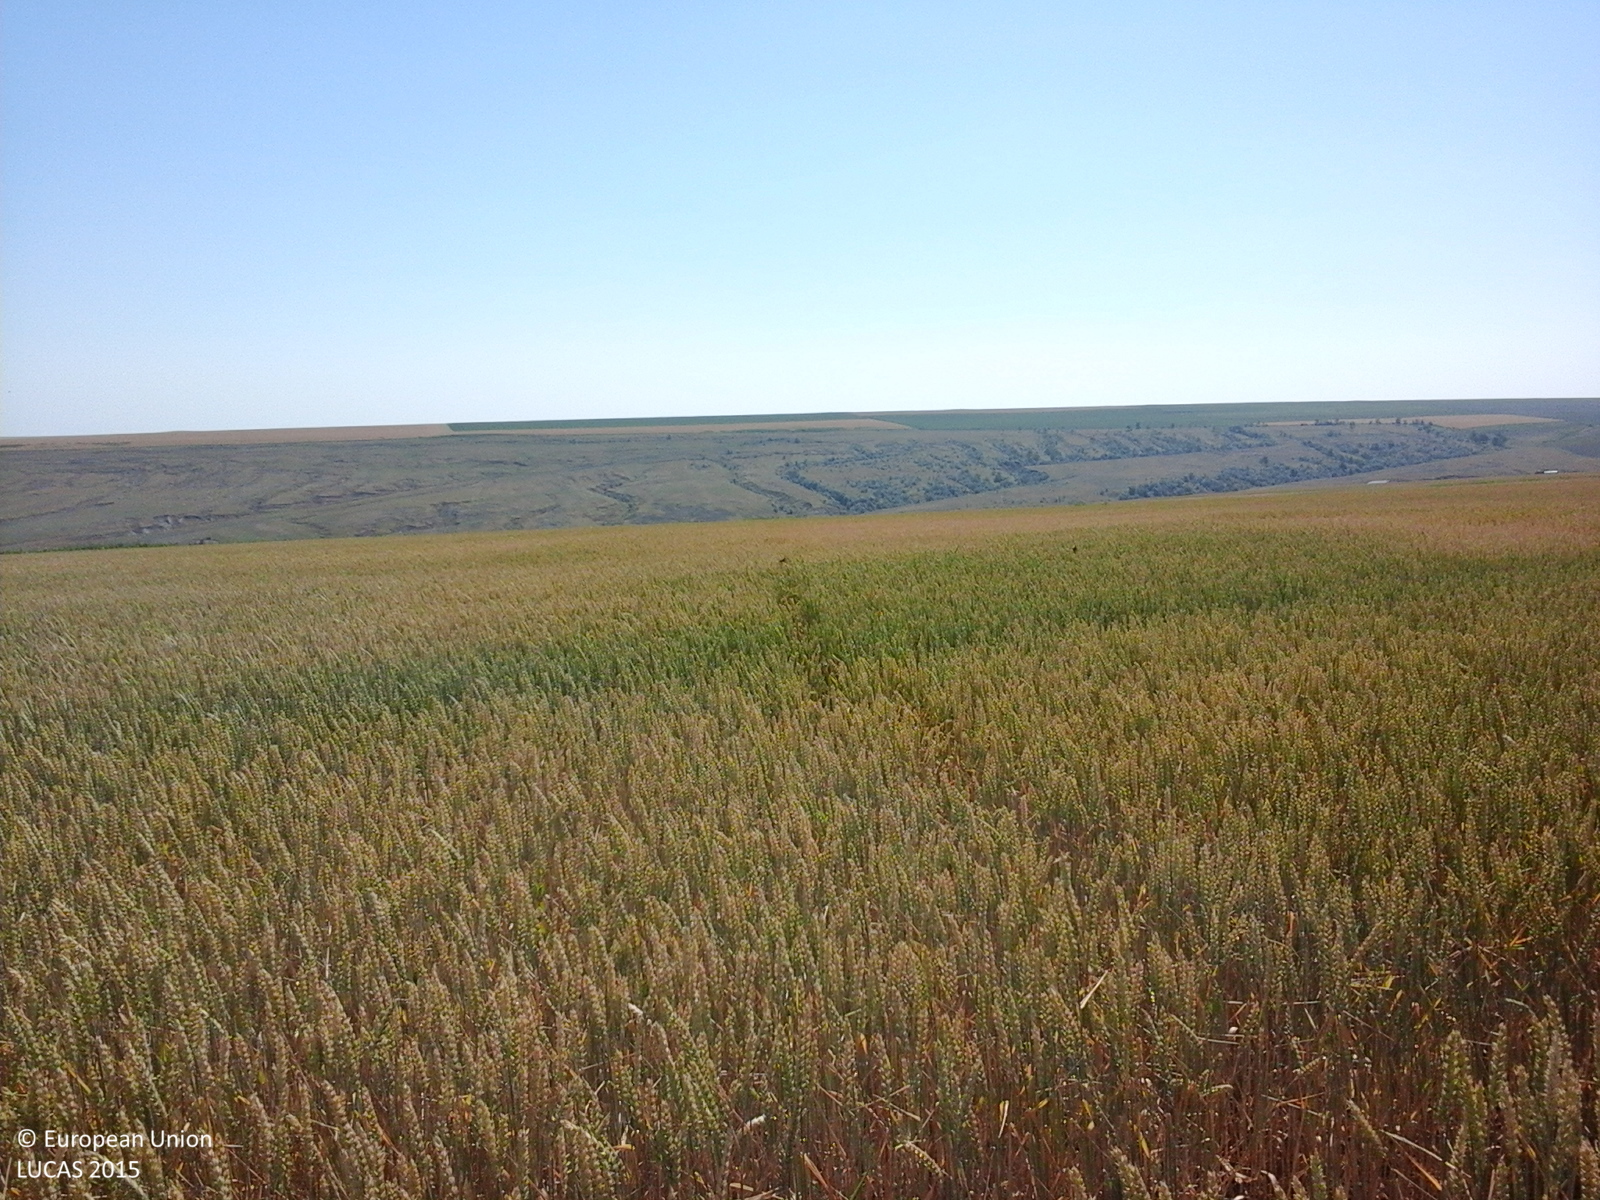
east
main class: Cropland
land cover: Common wheat
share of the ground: > 75 %
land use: Agriculture (excluding fallow land and kitchen gardens)
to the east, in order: Common wheat
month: June
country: RO
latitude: 47.4699
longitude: 26.9378
